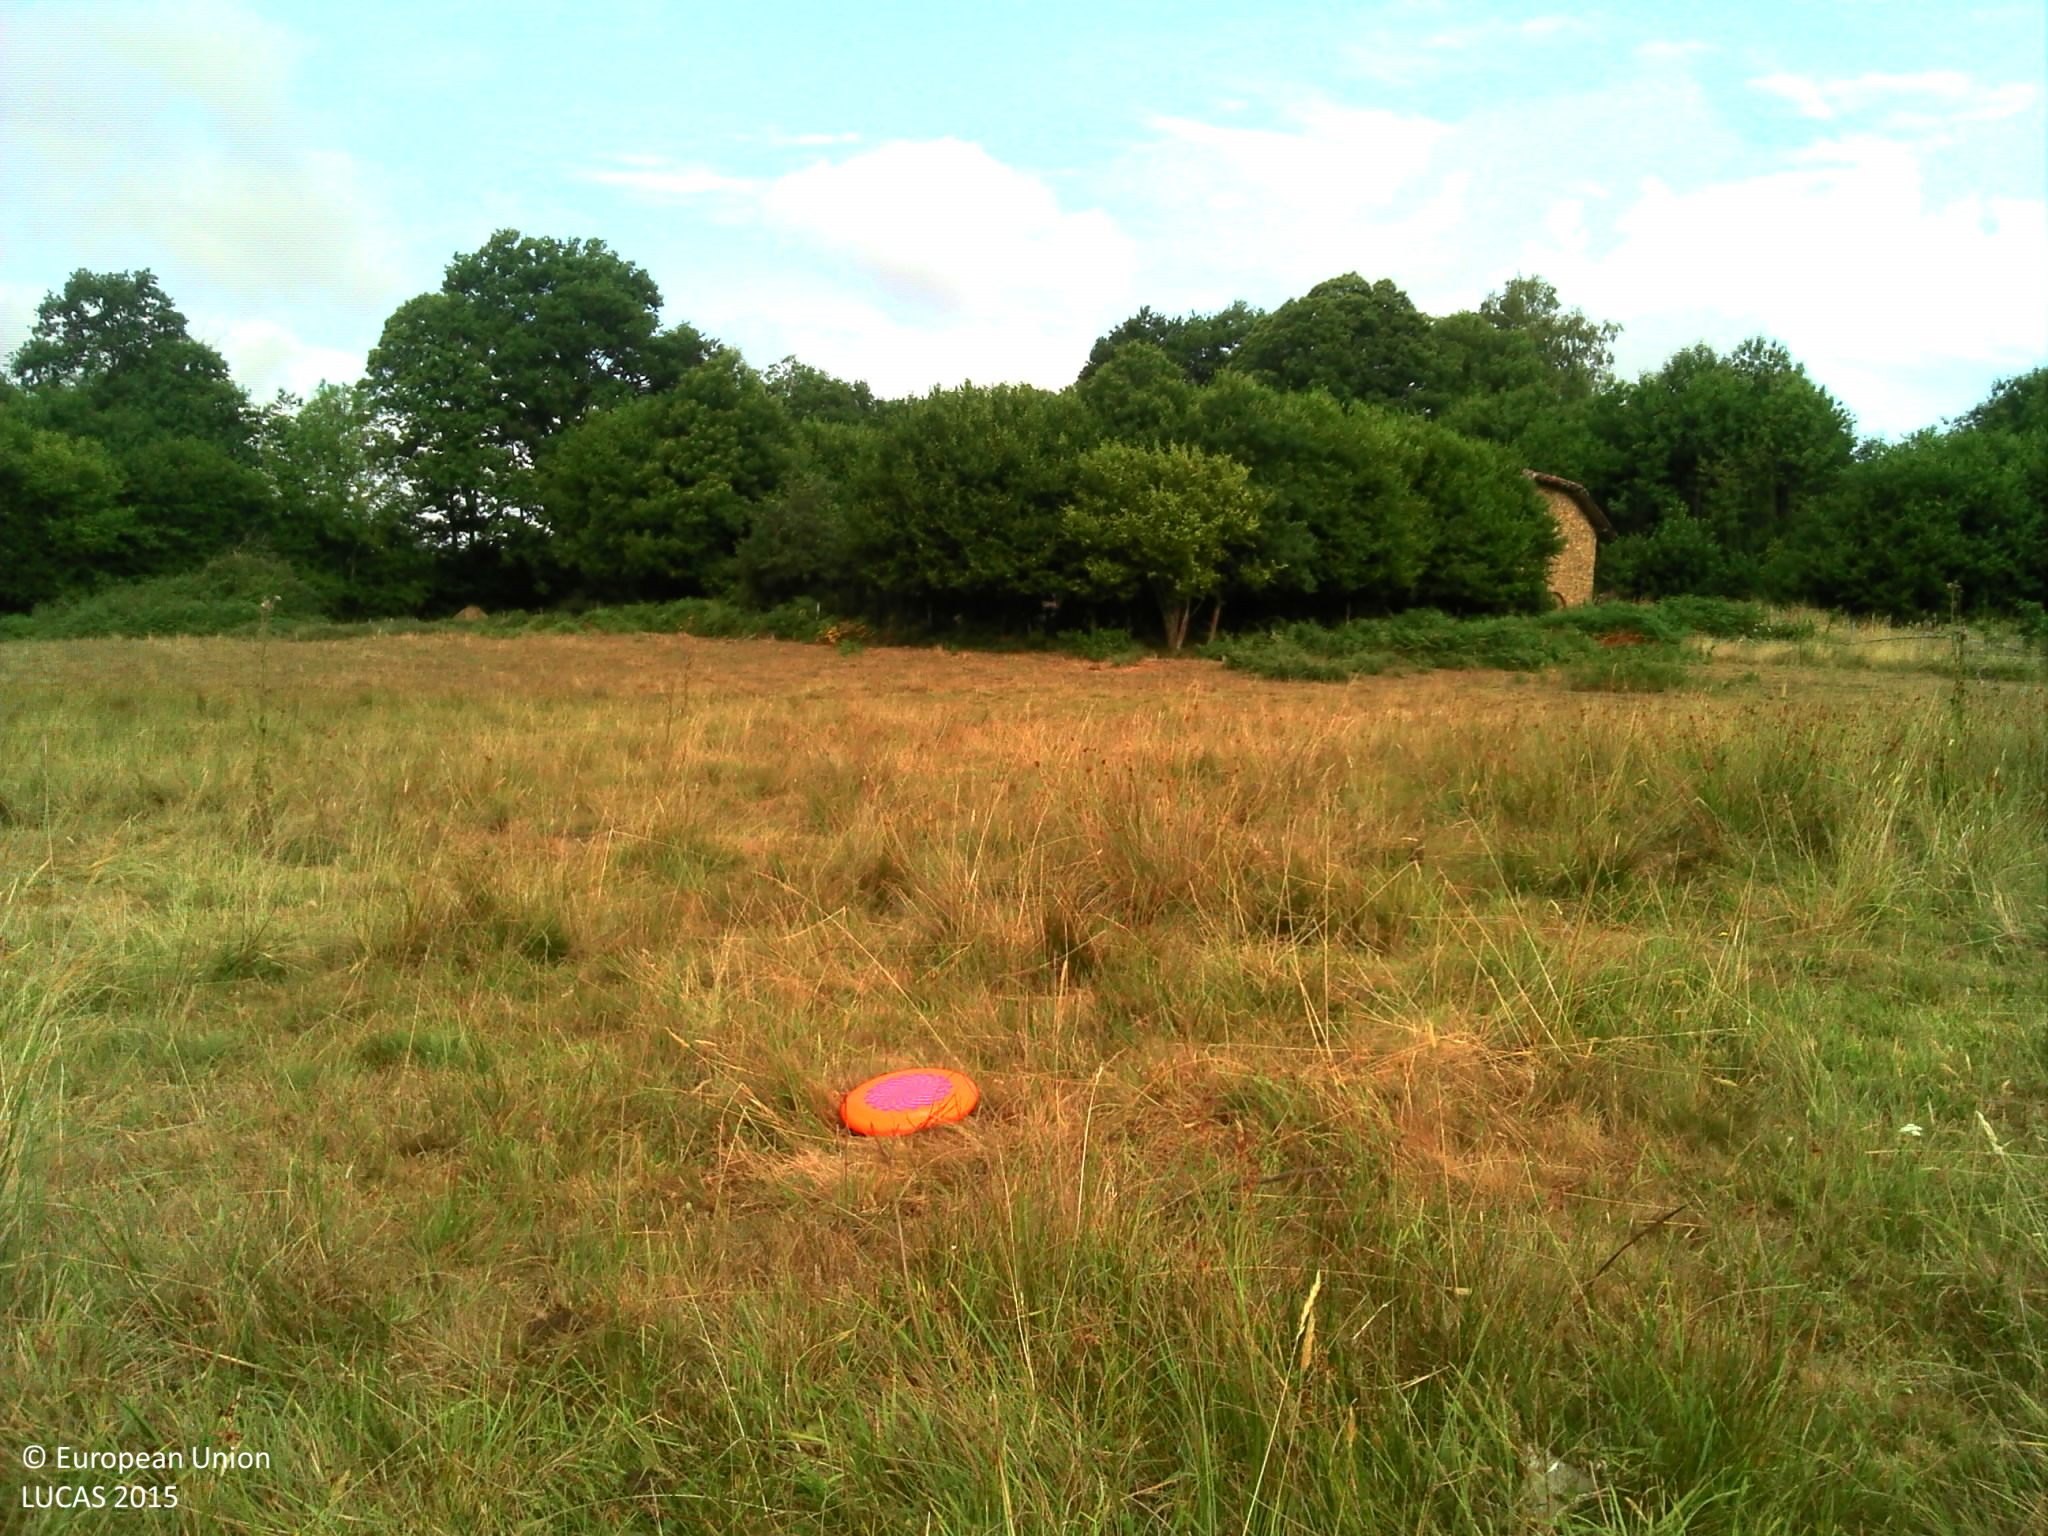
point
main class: Grassland
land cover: Grassland without tree/shrub cover
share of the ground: > 75 %
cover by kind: herbaceous plants 95 %
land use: Agriculture (excluding fallow land and kitchen gardens)
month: July
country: FR
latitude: 45.8098
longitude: 1.0201
